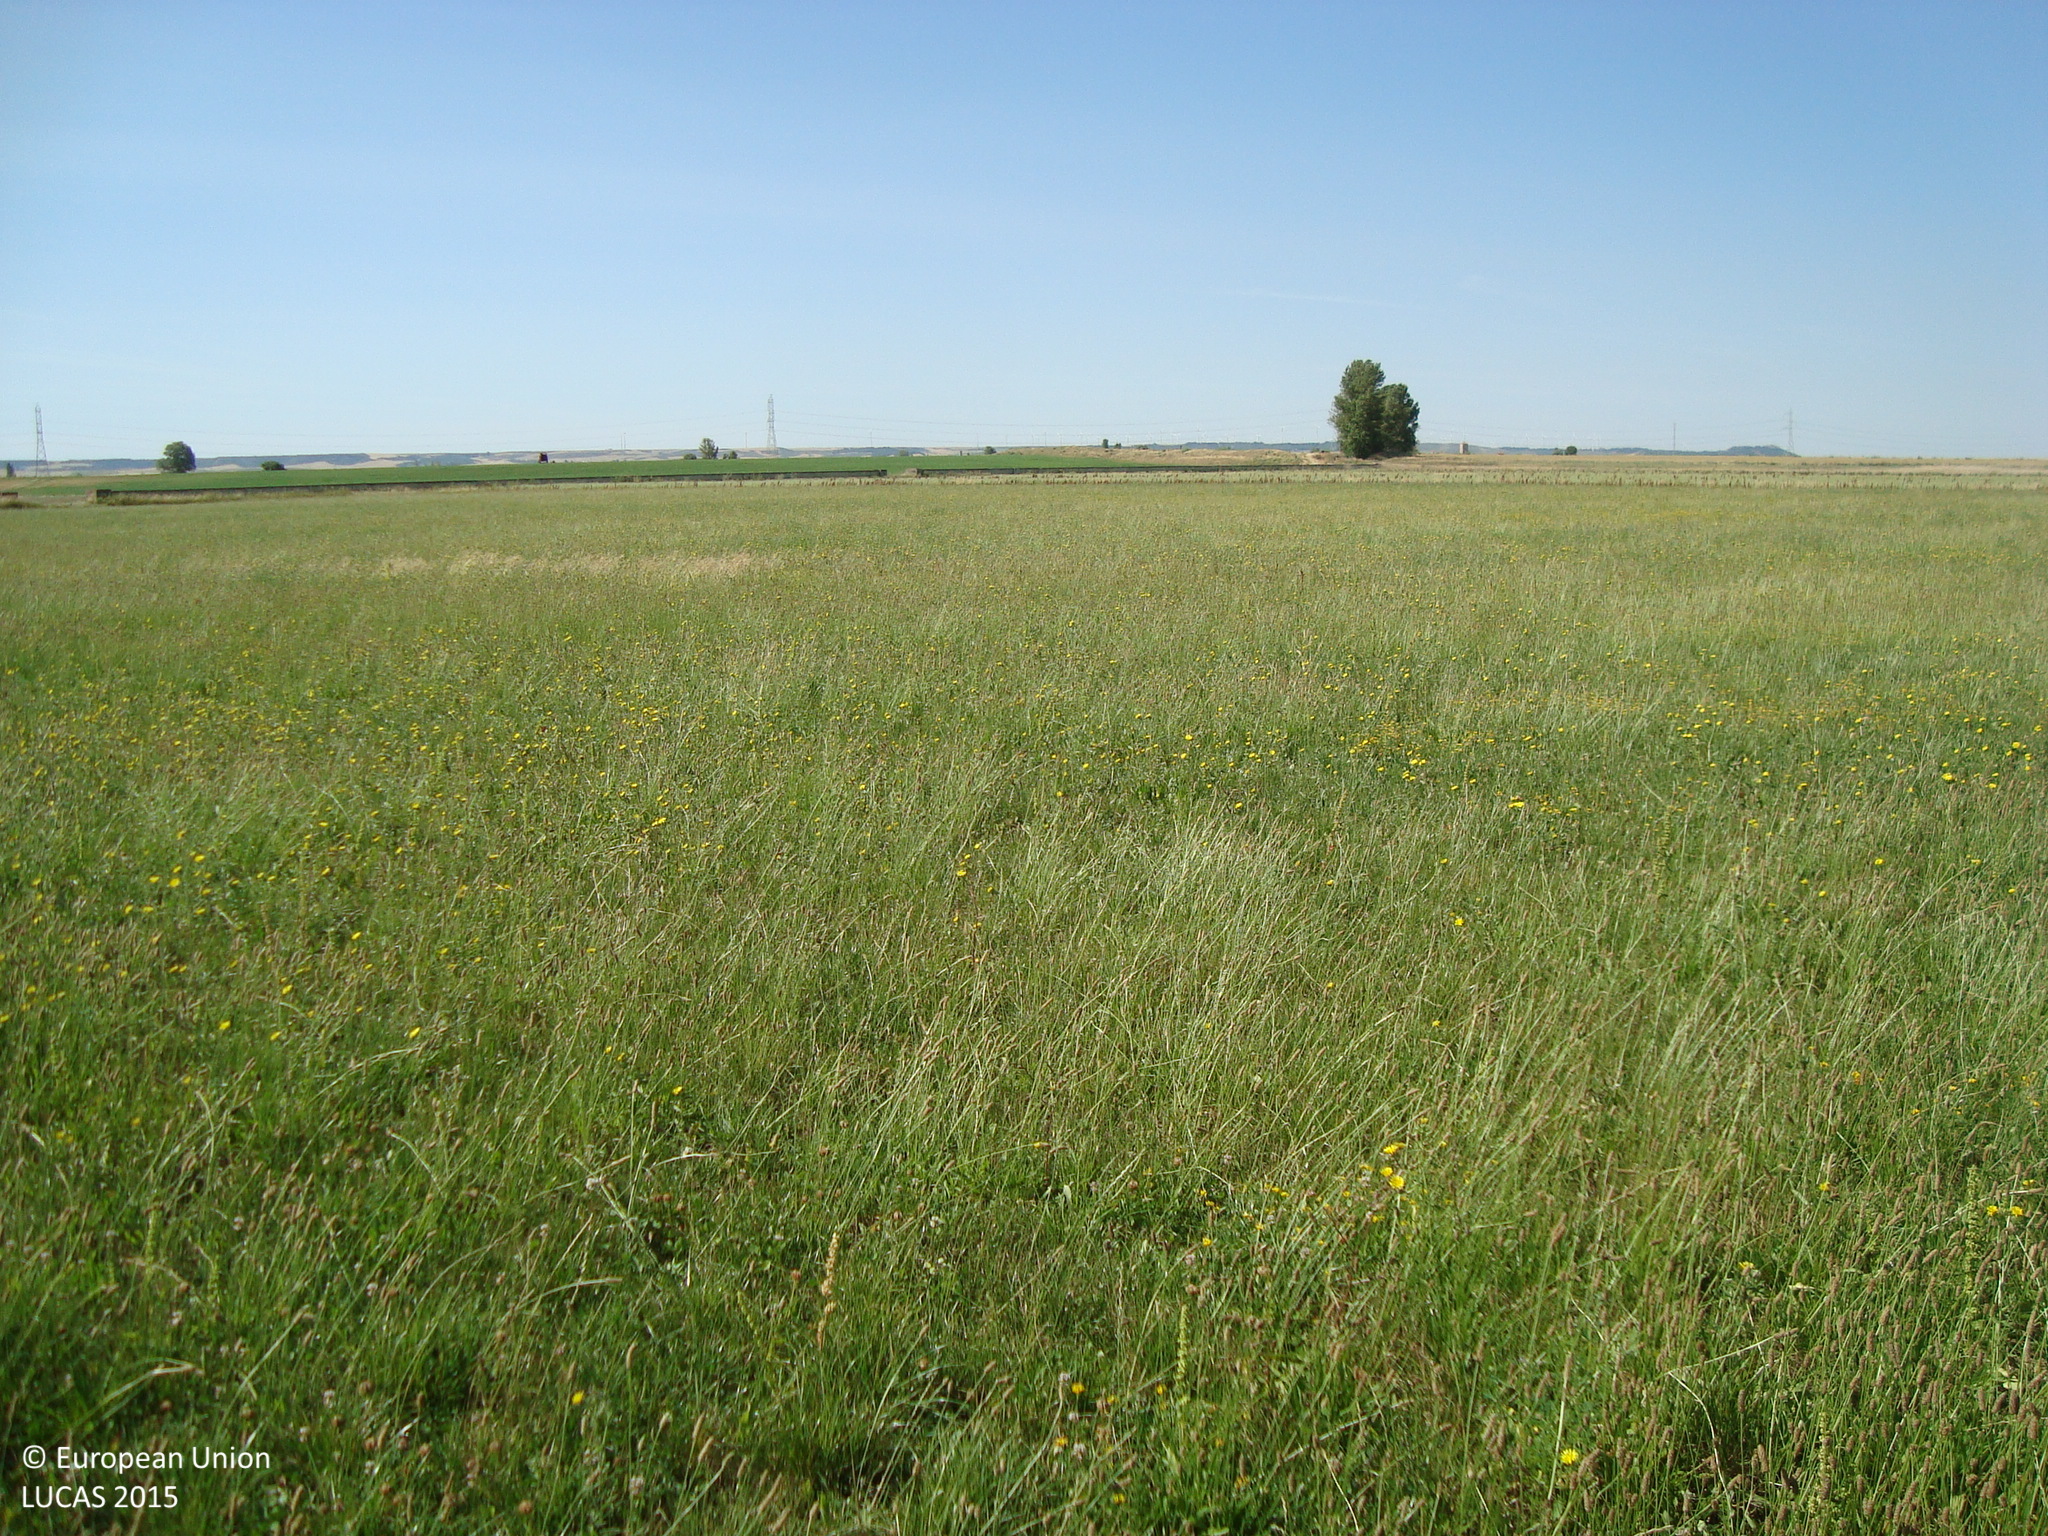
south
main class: Cropland
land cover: Other leguminous and mixtures for fodder
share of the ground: > 75 %
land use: Agriculture (excluding fallow land and kitchen gardens)
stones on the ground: > 50 %
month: July
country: ES
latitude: 42.0505
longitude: -4.7054
